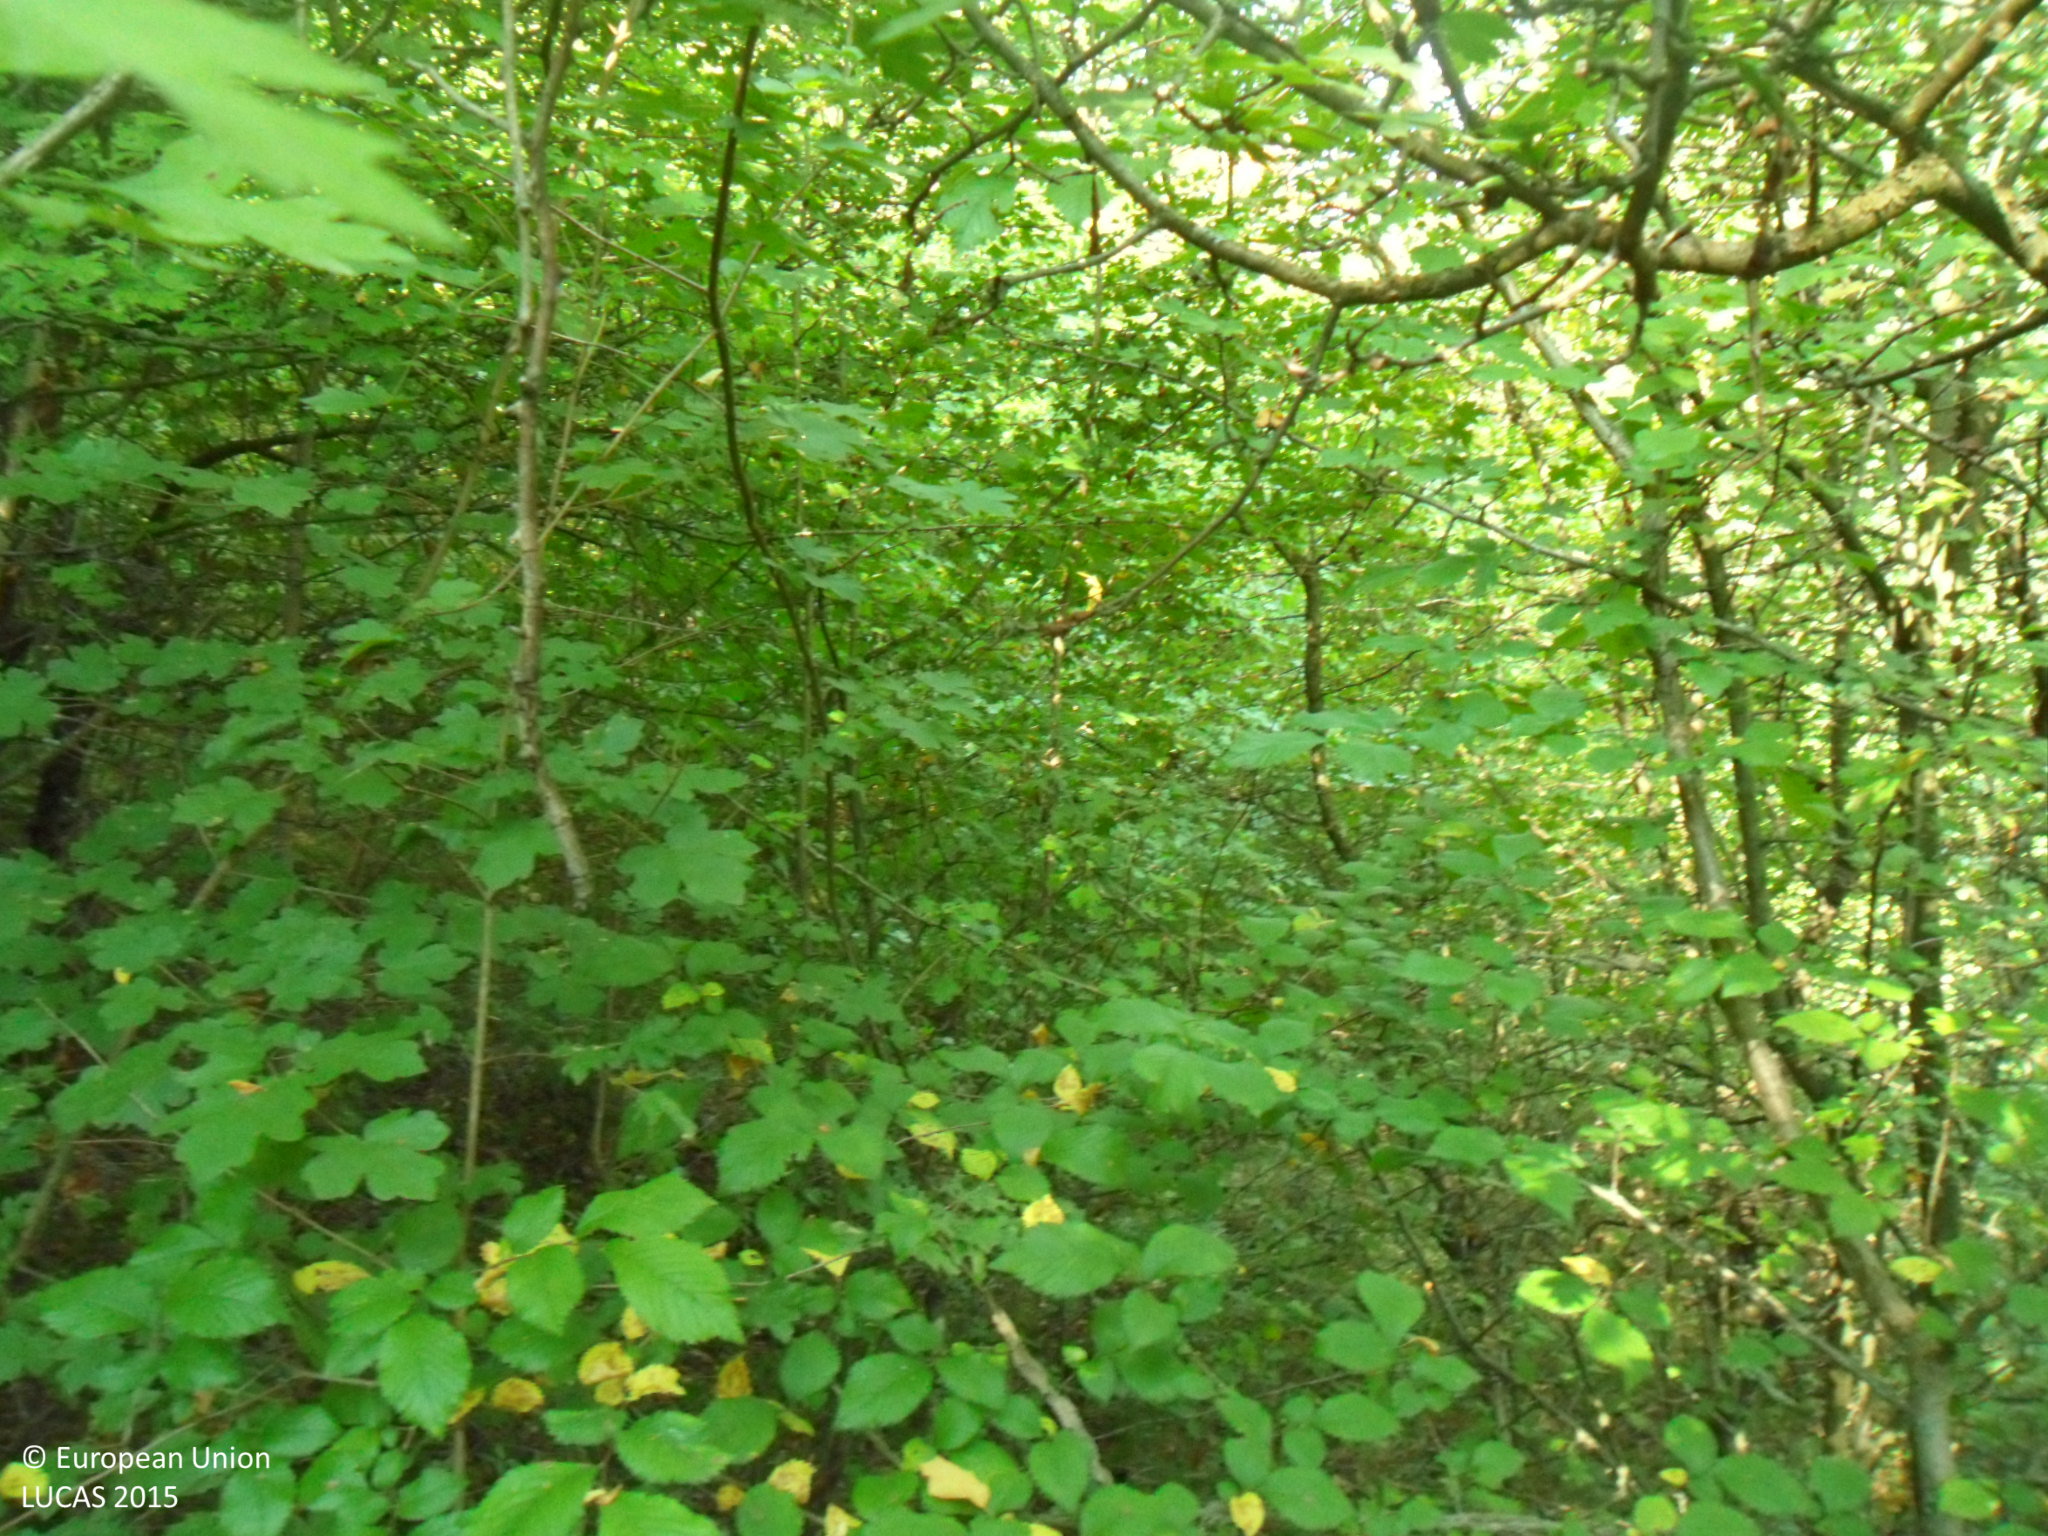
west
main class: Woodland
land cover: Broadleaved woodland
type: mesophytic deciduous forest
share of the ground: 25 - 50 %
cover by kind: shrubs 60 %, broadleaved forest trees 30 %, herbaceous plants 10 %
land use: Forestry
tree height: > 5 m
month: September
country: BG
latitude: 43.4838
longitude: 26.6895
